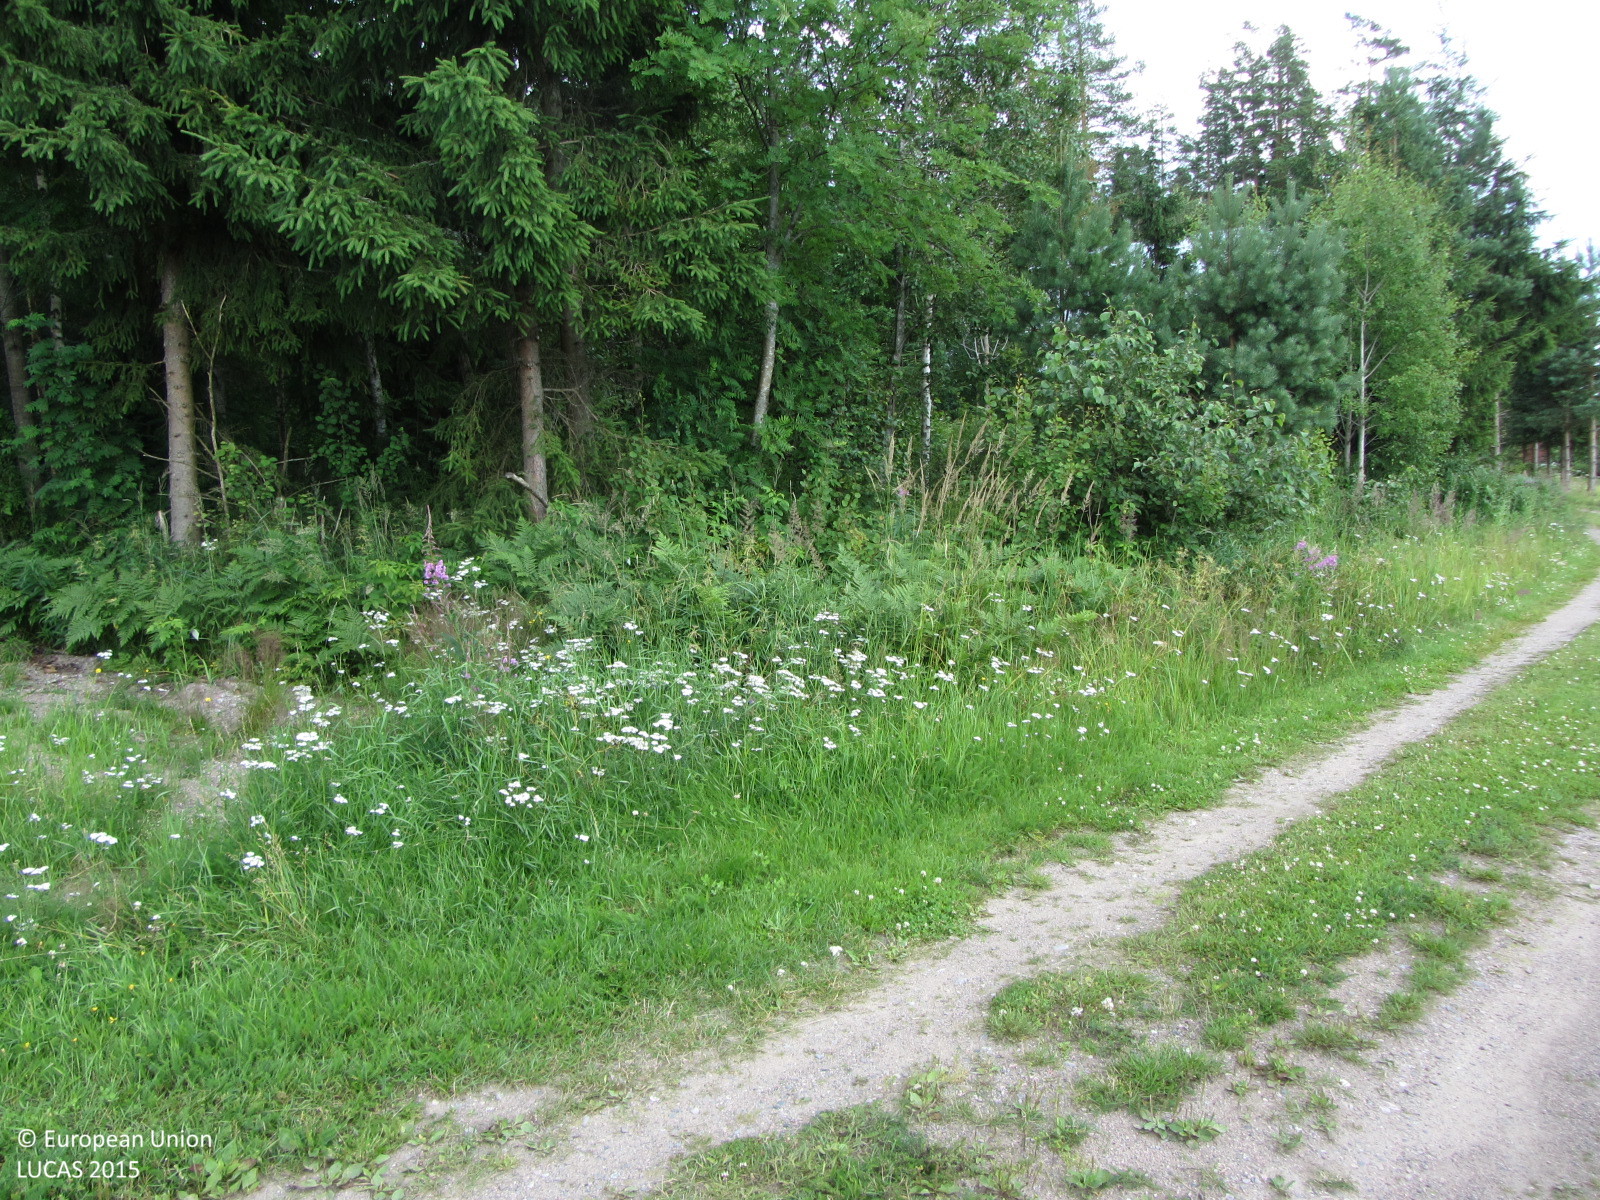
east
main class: Cropland
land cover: Barley
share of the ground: > 75 %
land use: Agriculture (excluding fallow land and kitchen gardens)
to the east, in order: Barley; Grass margins; Ditches and canals; Grass margins; Arable land (only in case pi)
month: July
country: FI
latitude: 60.6729
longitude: 24.5097
